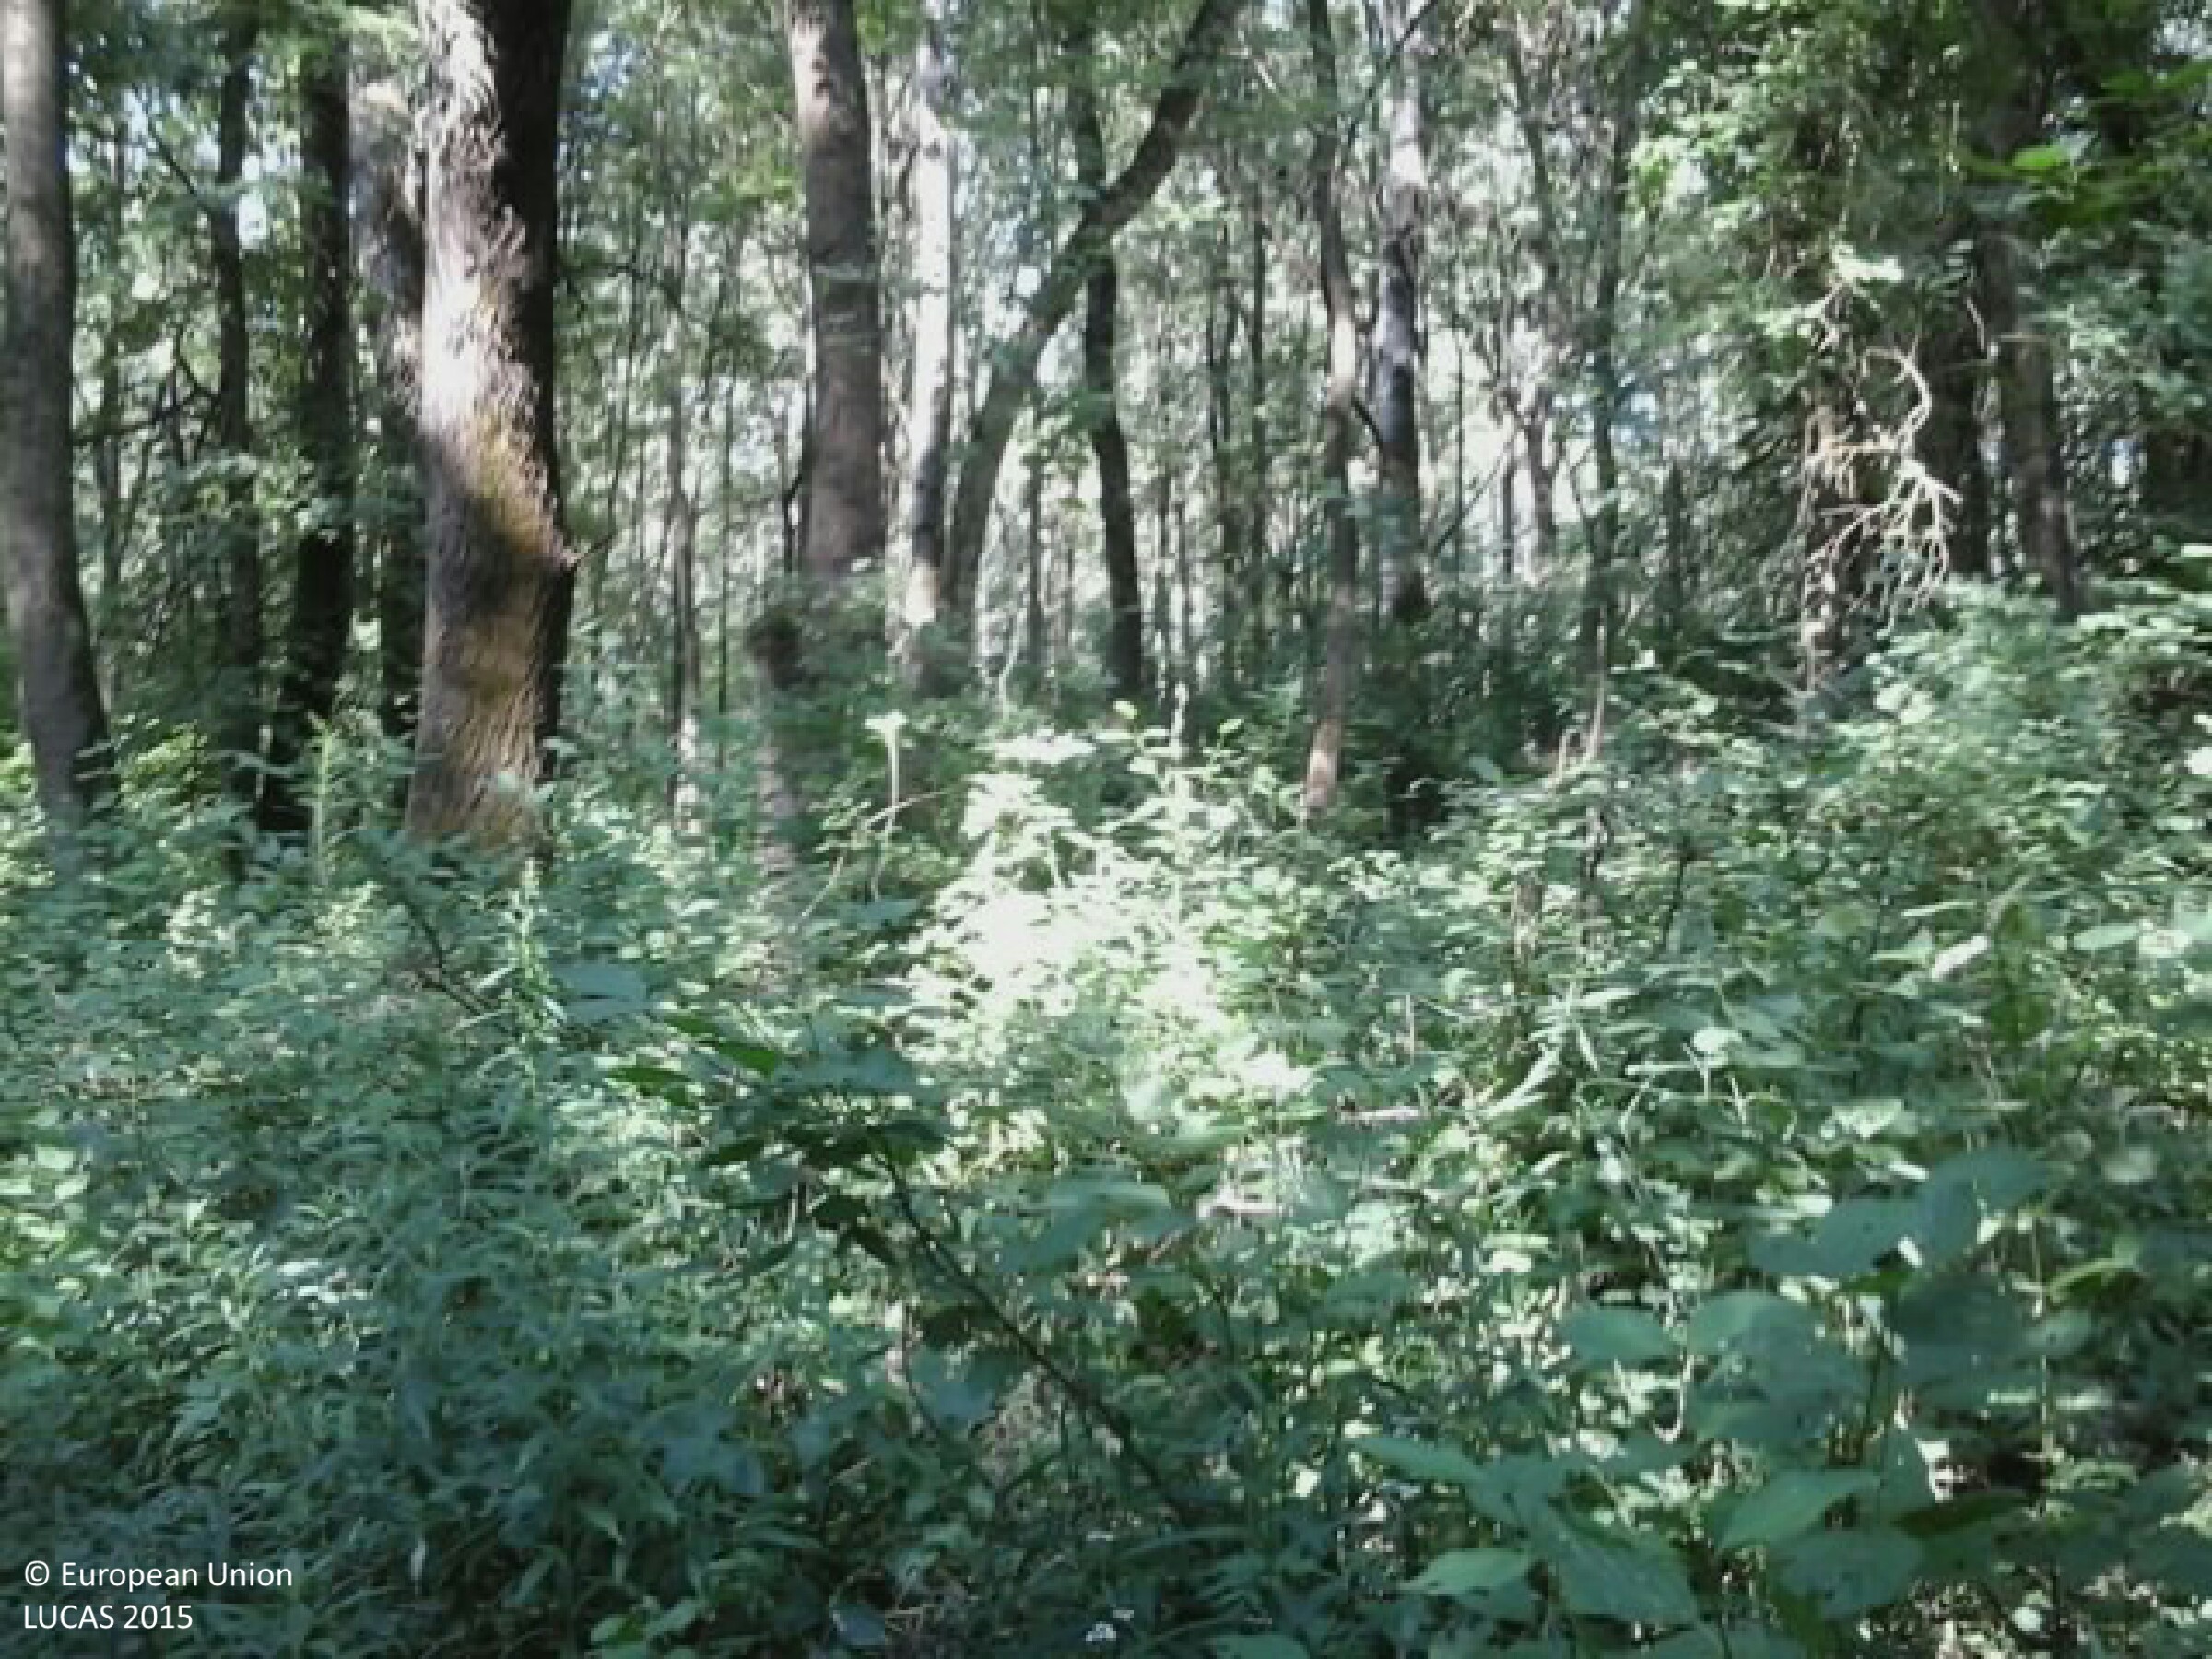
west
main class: Woodland
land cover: Broadleaved woodland
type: exotic forest
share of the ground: > 75 %
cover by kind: broadleaved forest trees 80 %, herbaceous plants 15 %, shrubs 5 %
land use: Forestry
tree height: > 5 m
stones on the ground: < 10 %
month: July
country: HU
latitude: 46.1487
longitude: 18.8281
